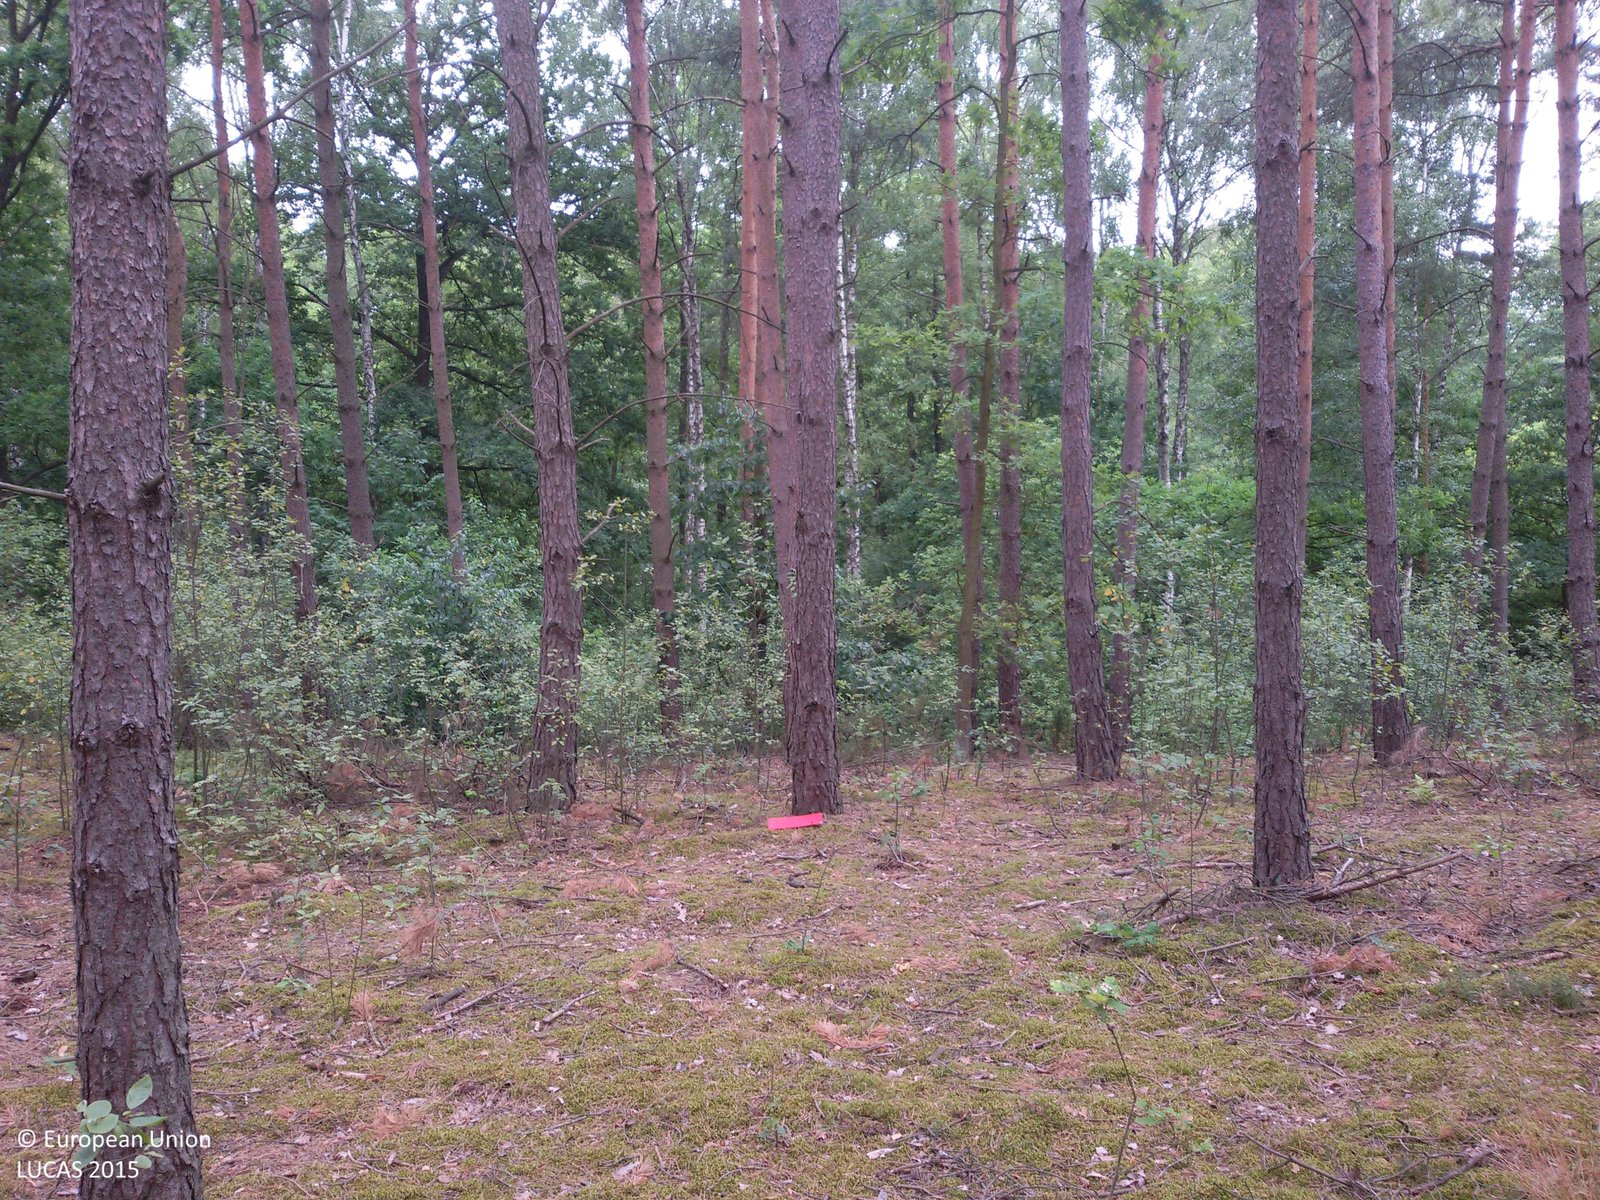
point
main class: Woodland
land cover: Pine dominated coniferous woodland
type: hemiboreal forest and nemoral coniferous forest and mixed broadleaved-coniferous forest
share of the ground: 50 - 75 %
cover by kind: coniferous forest trees 75 %, herbaceous plants 10 %, lichens and mosses 10 %, shrubs 5 %
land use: Forestry
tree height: > 5 m
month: July
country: PL
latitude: 52.8242
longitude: 19.0911
